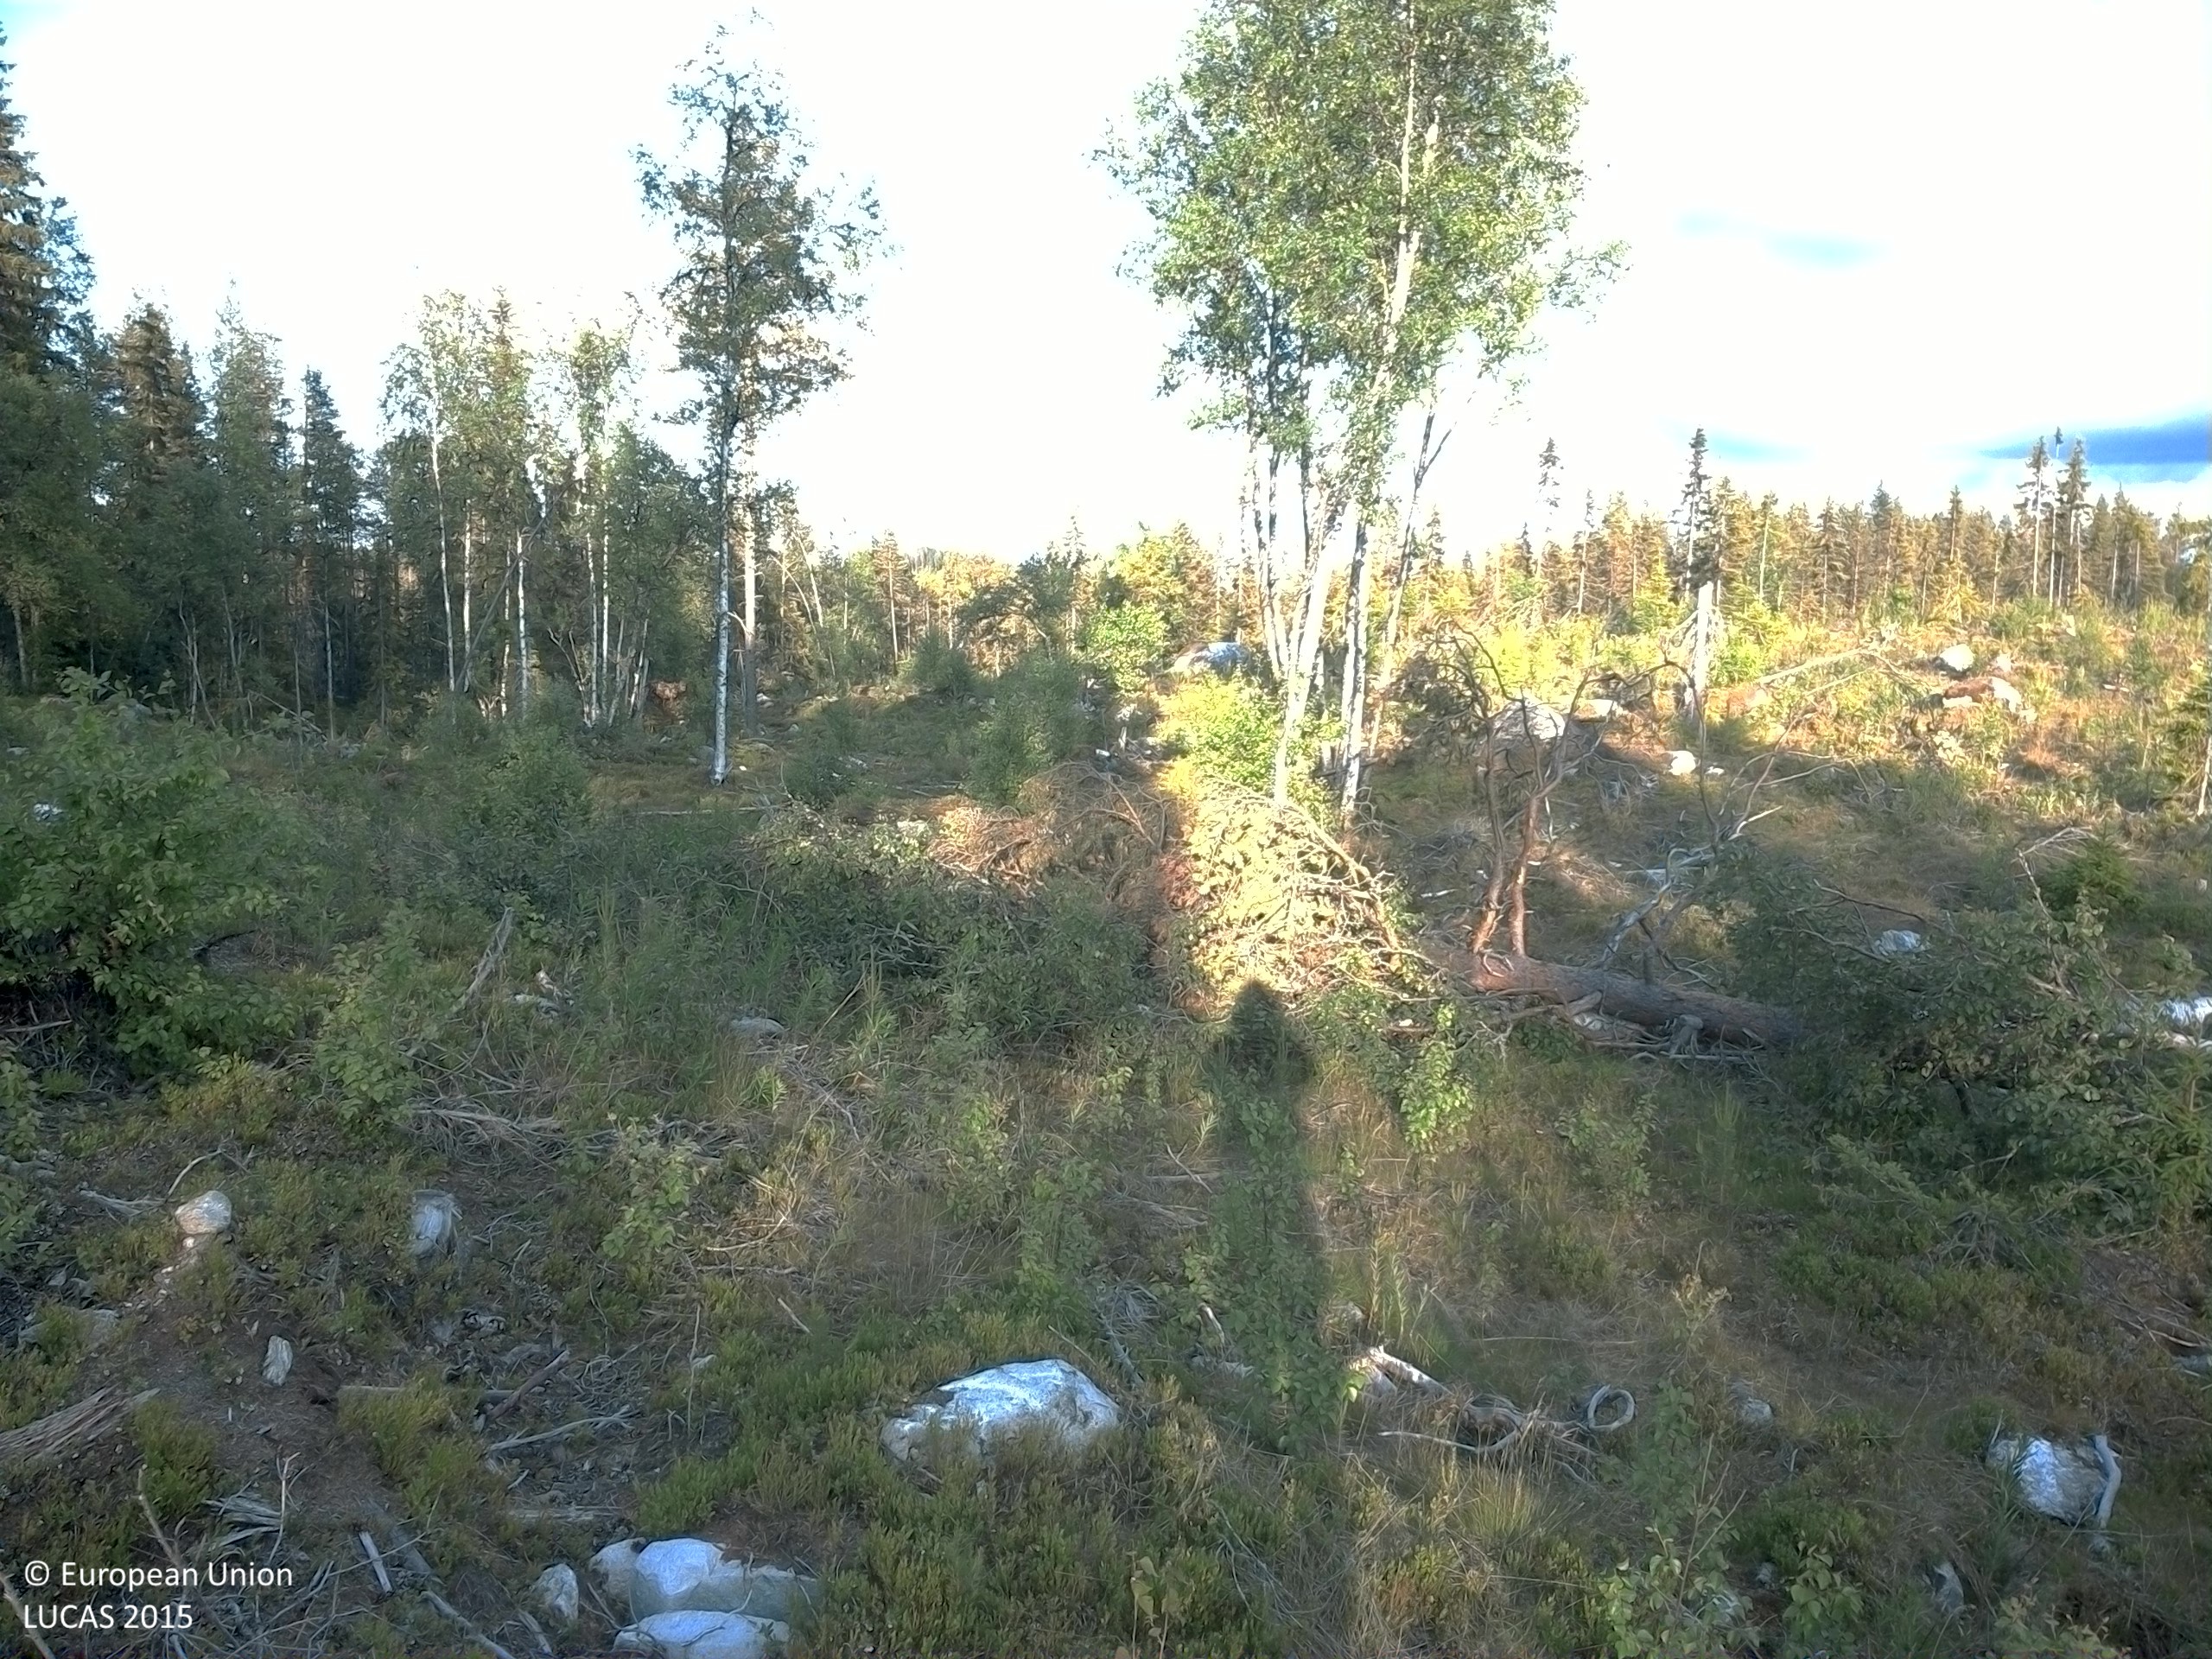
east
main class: Woodland
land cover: Pine dominated mixed woodland
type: boreal forest
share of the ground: 10 - 25 %
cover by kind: herbaceous plants 30 %, shrubs 20 %, lichens and mosses 15 %, consolidated bare surface 15 %, coniferous forest trees 10 %, broadleaved forest trees 5 %, unconsolidated bare surface 5 %
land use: Forestry
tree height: < 5 m
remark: Clear cut
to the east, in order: Pine dominated mixed woodland; Pine dominated coniferous woodland; Shrubland with sparse tree cover; Pine dominated coniferous woodland; Shrubland with sparse tree cover; Peatbogs
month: July
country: SE
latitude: 64.3183
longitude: 16.5249
